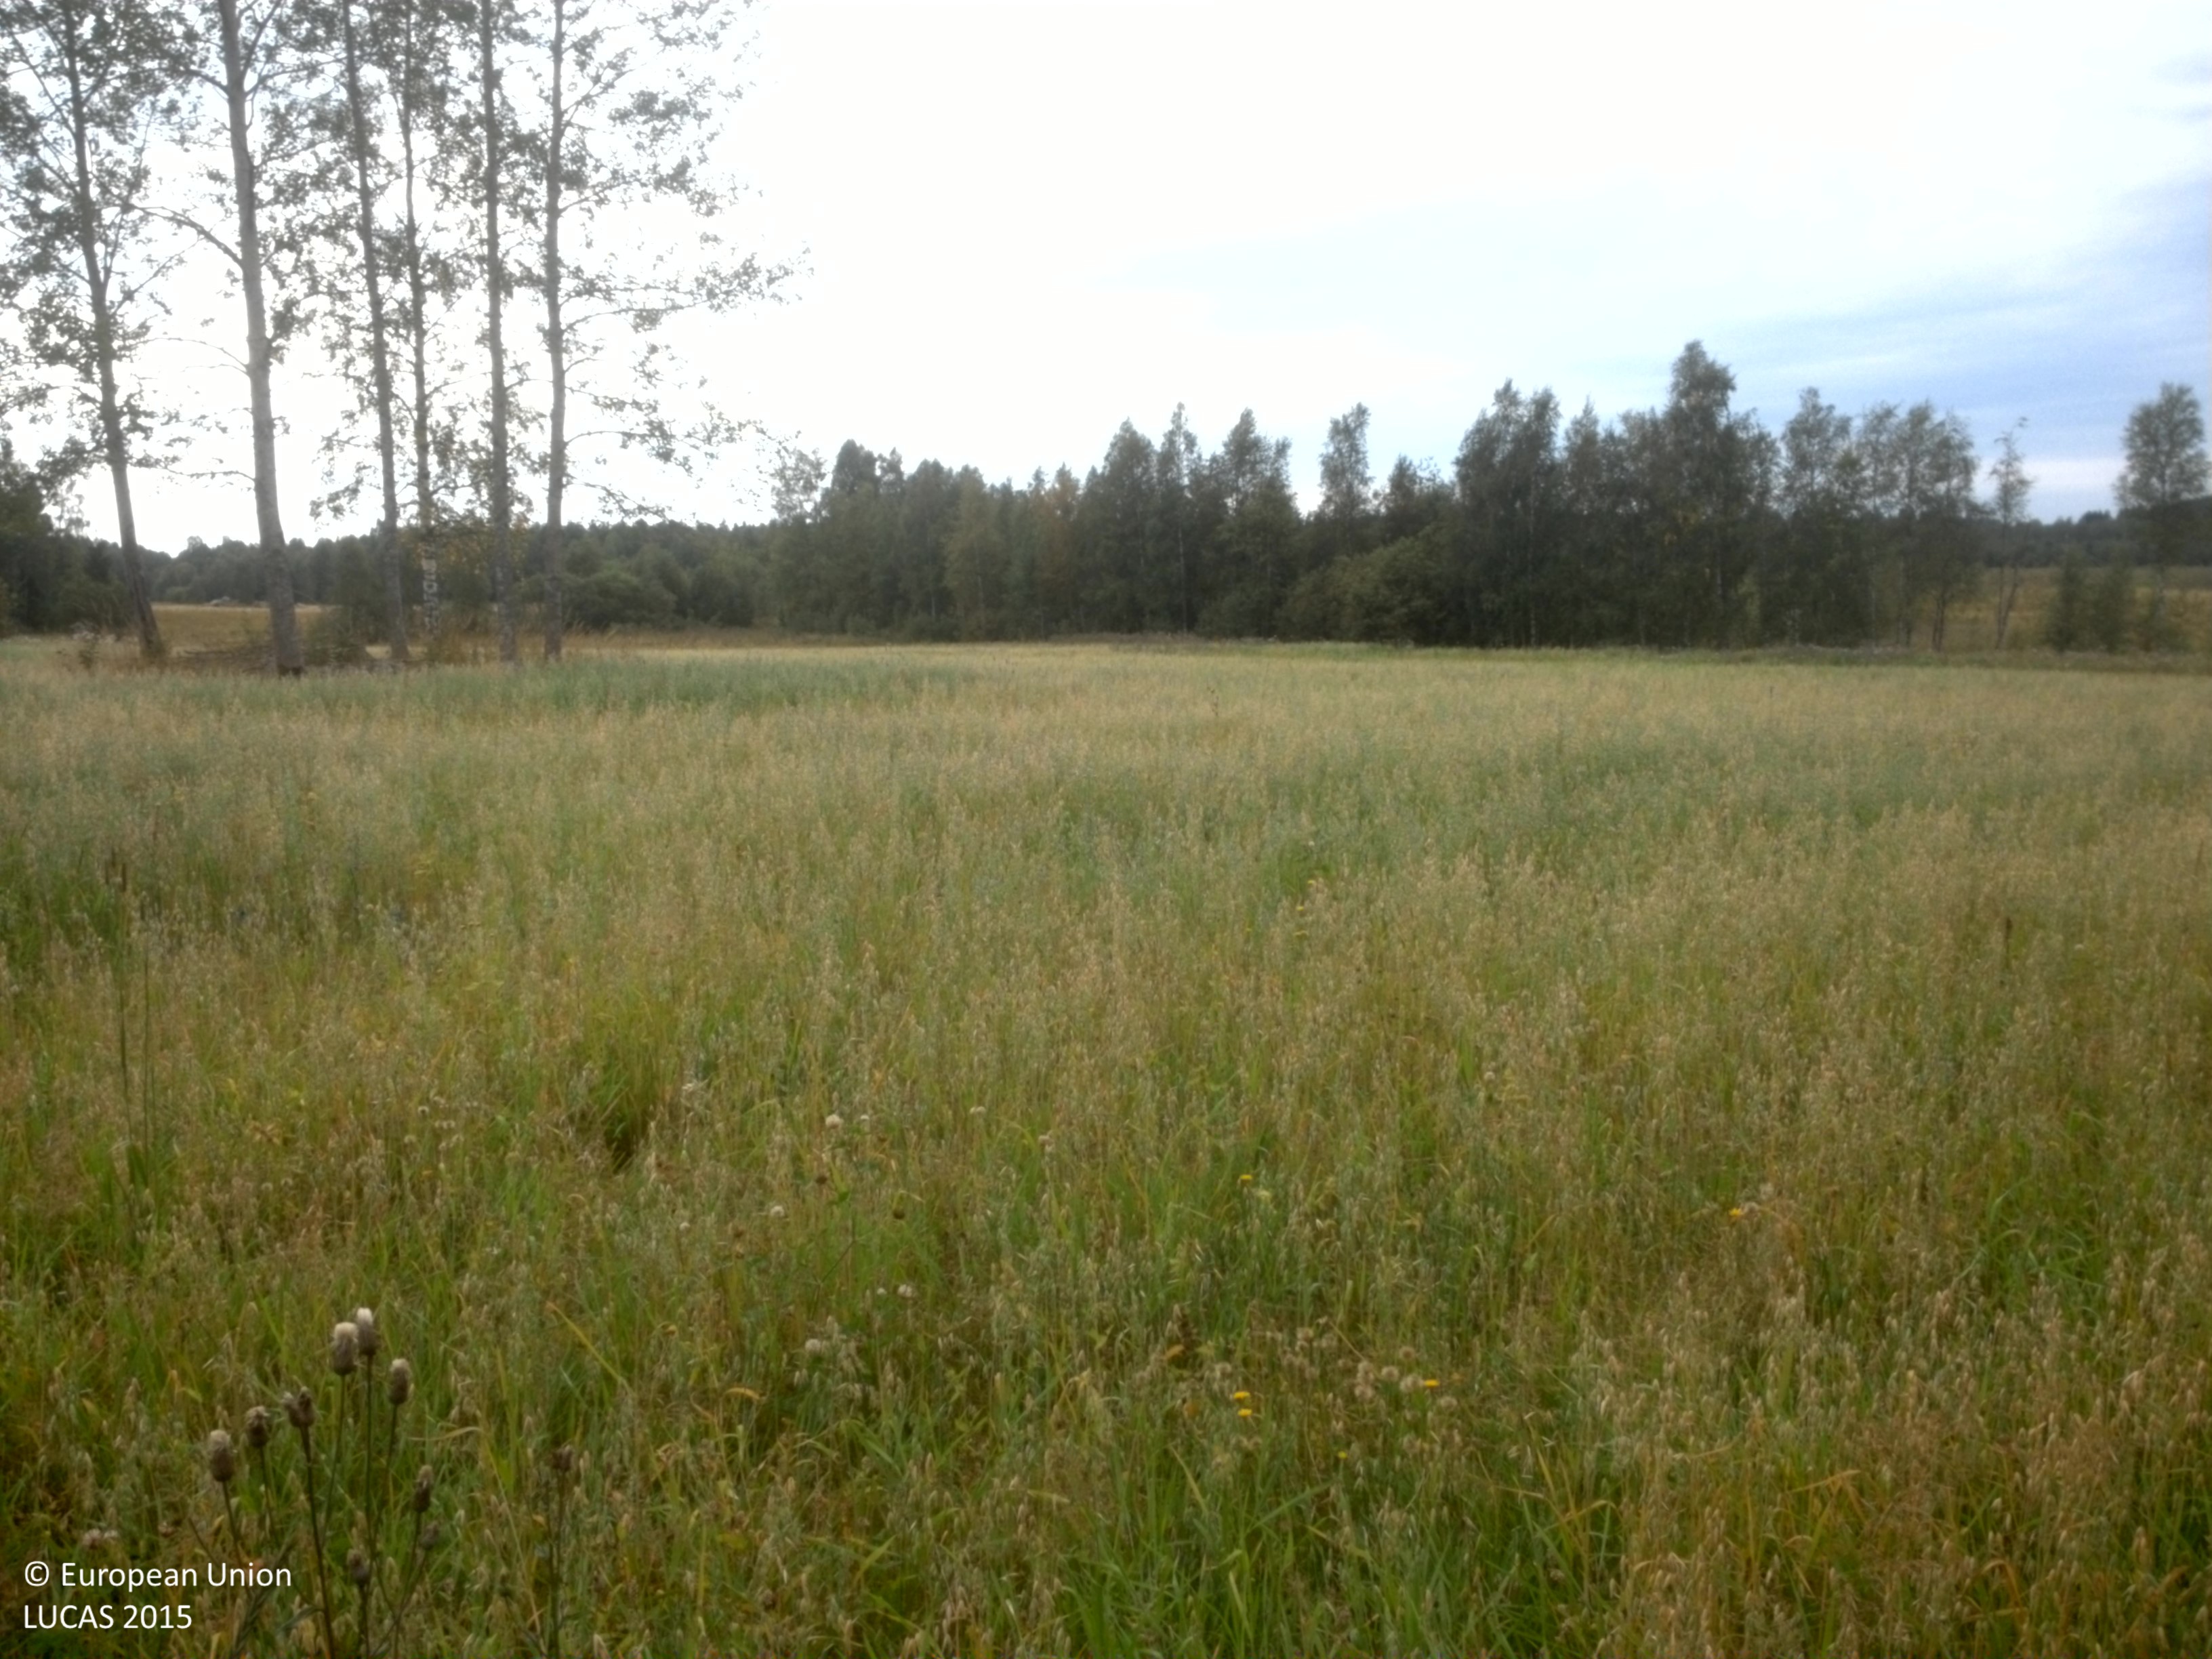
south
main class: Cropland
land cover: Oats
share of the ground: > 75 %
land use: Agriculture (excluding fallow land and kitchen gardens)
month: August
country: SE
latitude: 59.6824
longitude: 15.7983
